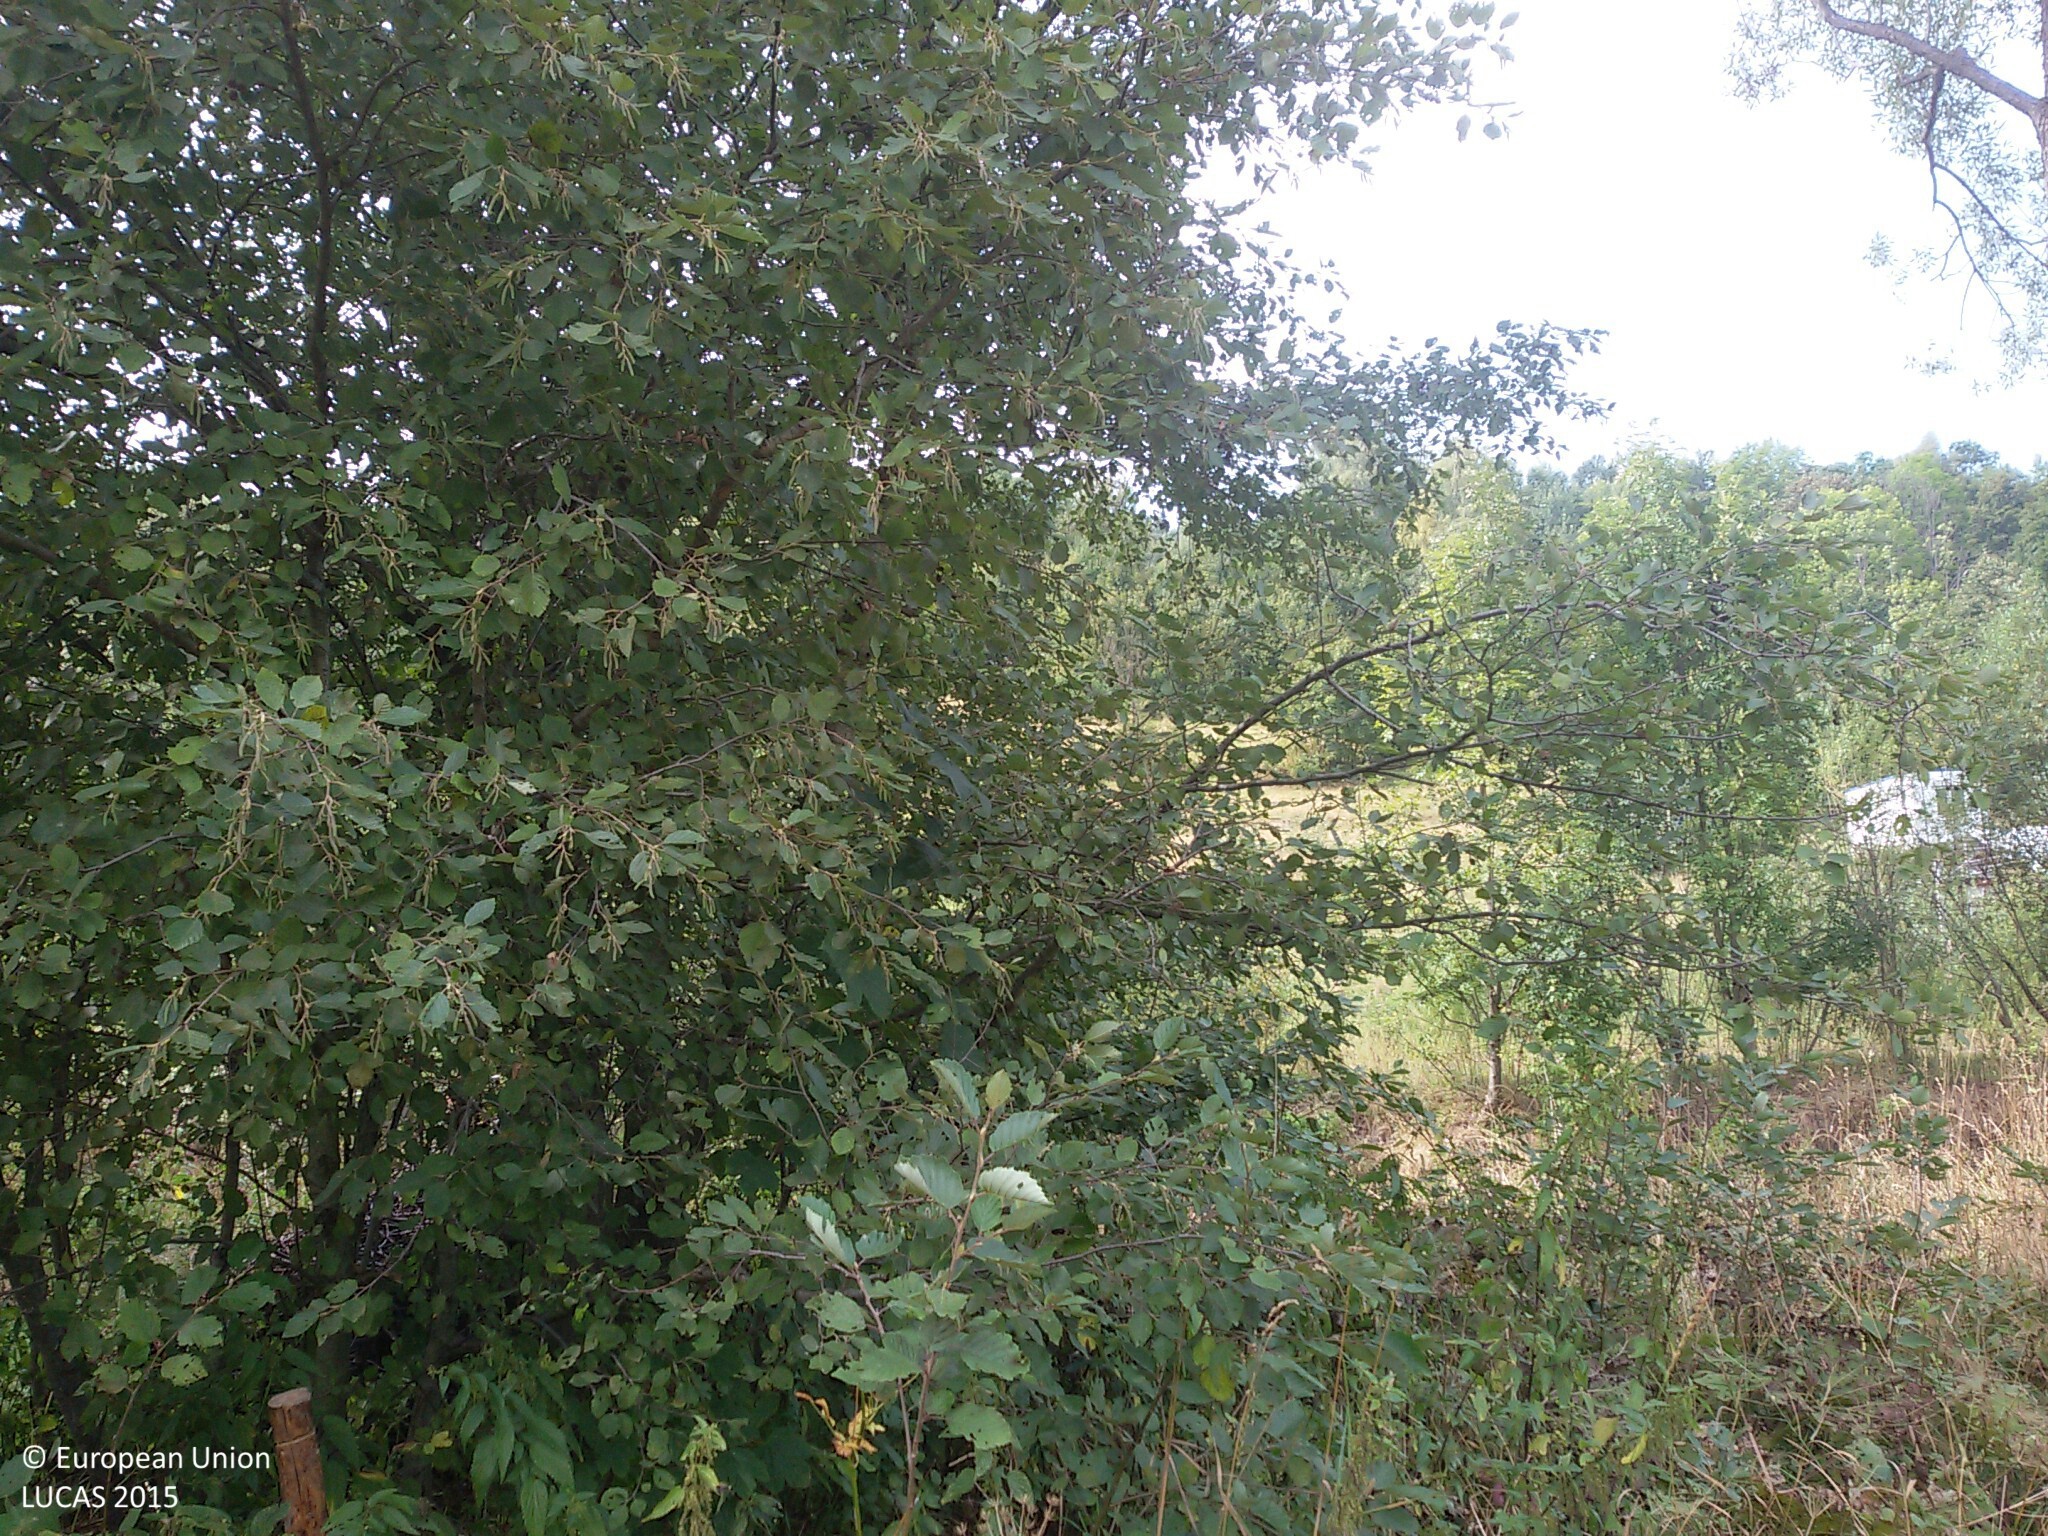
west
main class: Grassland
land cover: Grassland without tree/shrub cover
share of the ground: > 75 %
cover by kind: herbaceous plants 100 %
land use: Residential
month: August
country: PL
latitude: 49.6500
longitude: 19.4028
